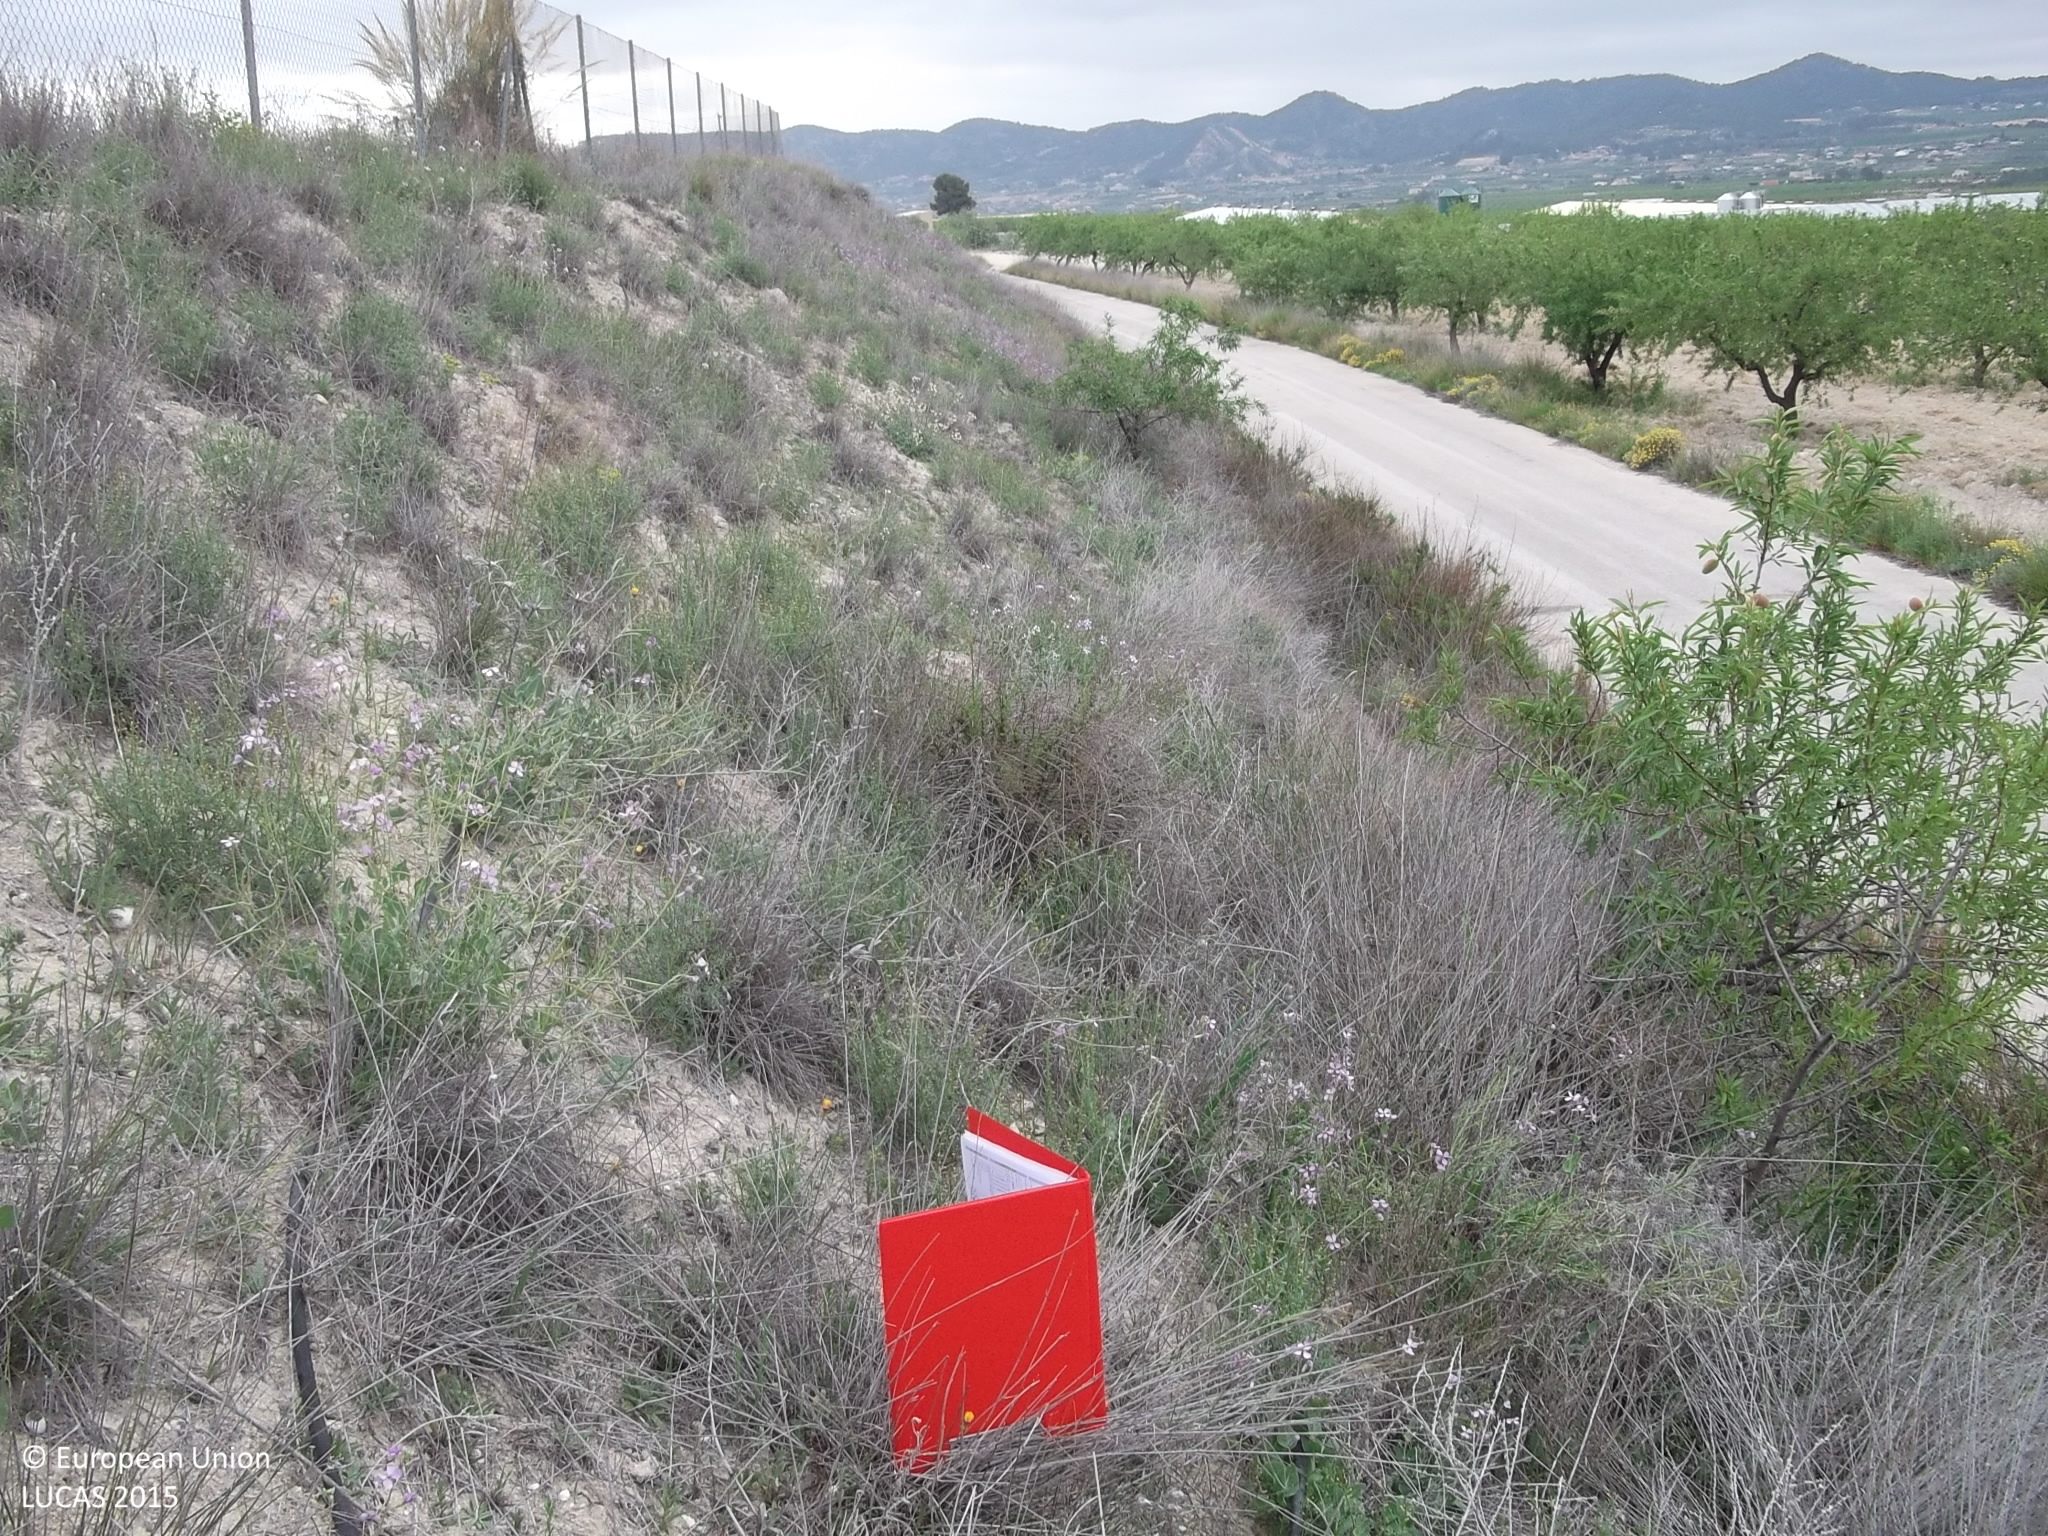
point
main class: Grassland
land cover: Grassland without tree/shrub cover
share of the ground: 10 - 25 %
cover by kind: consolidated bare surface 70 %, herbaceous plants 30 %
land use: Abandoned areas
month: April
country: ES
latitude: 37.9729
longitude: -1.5631
